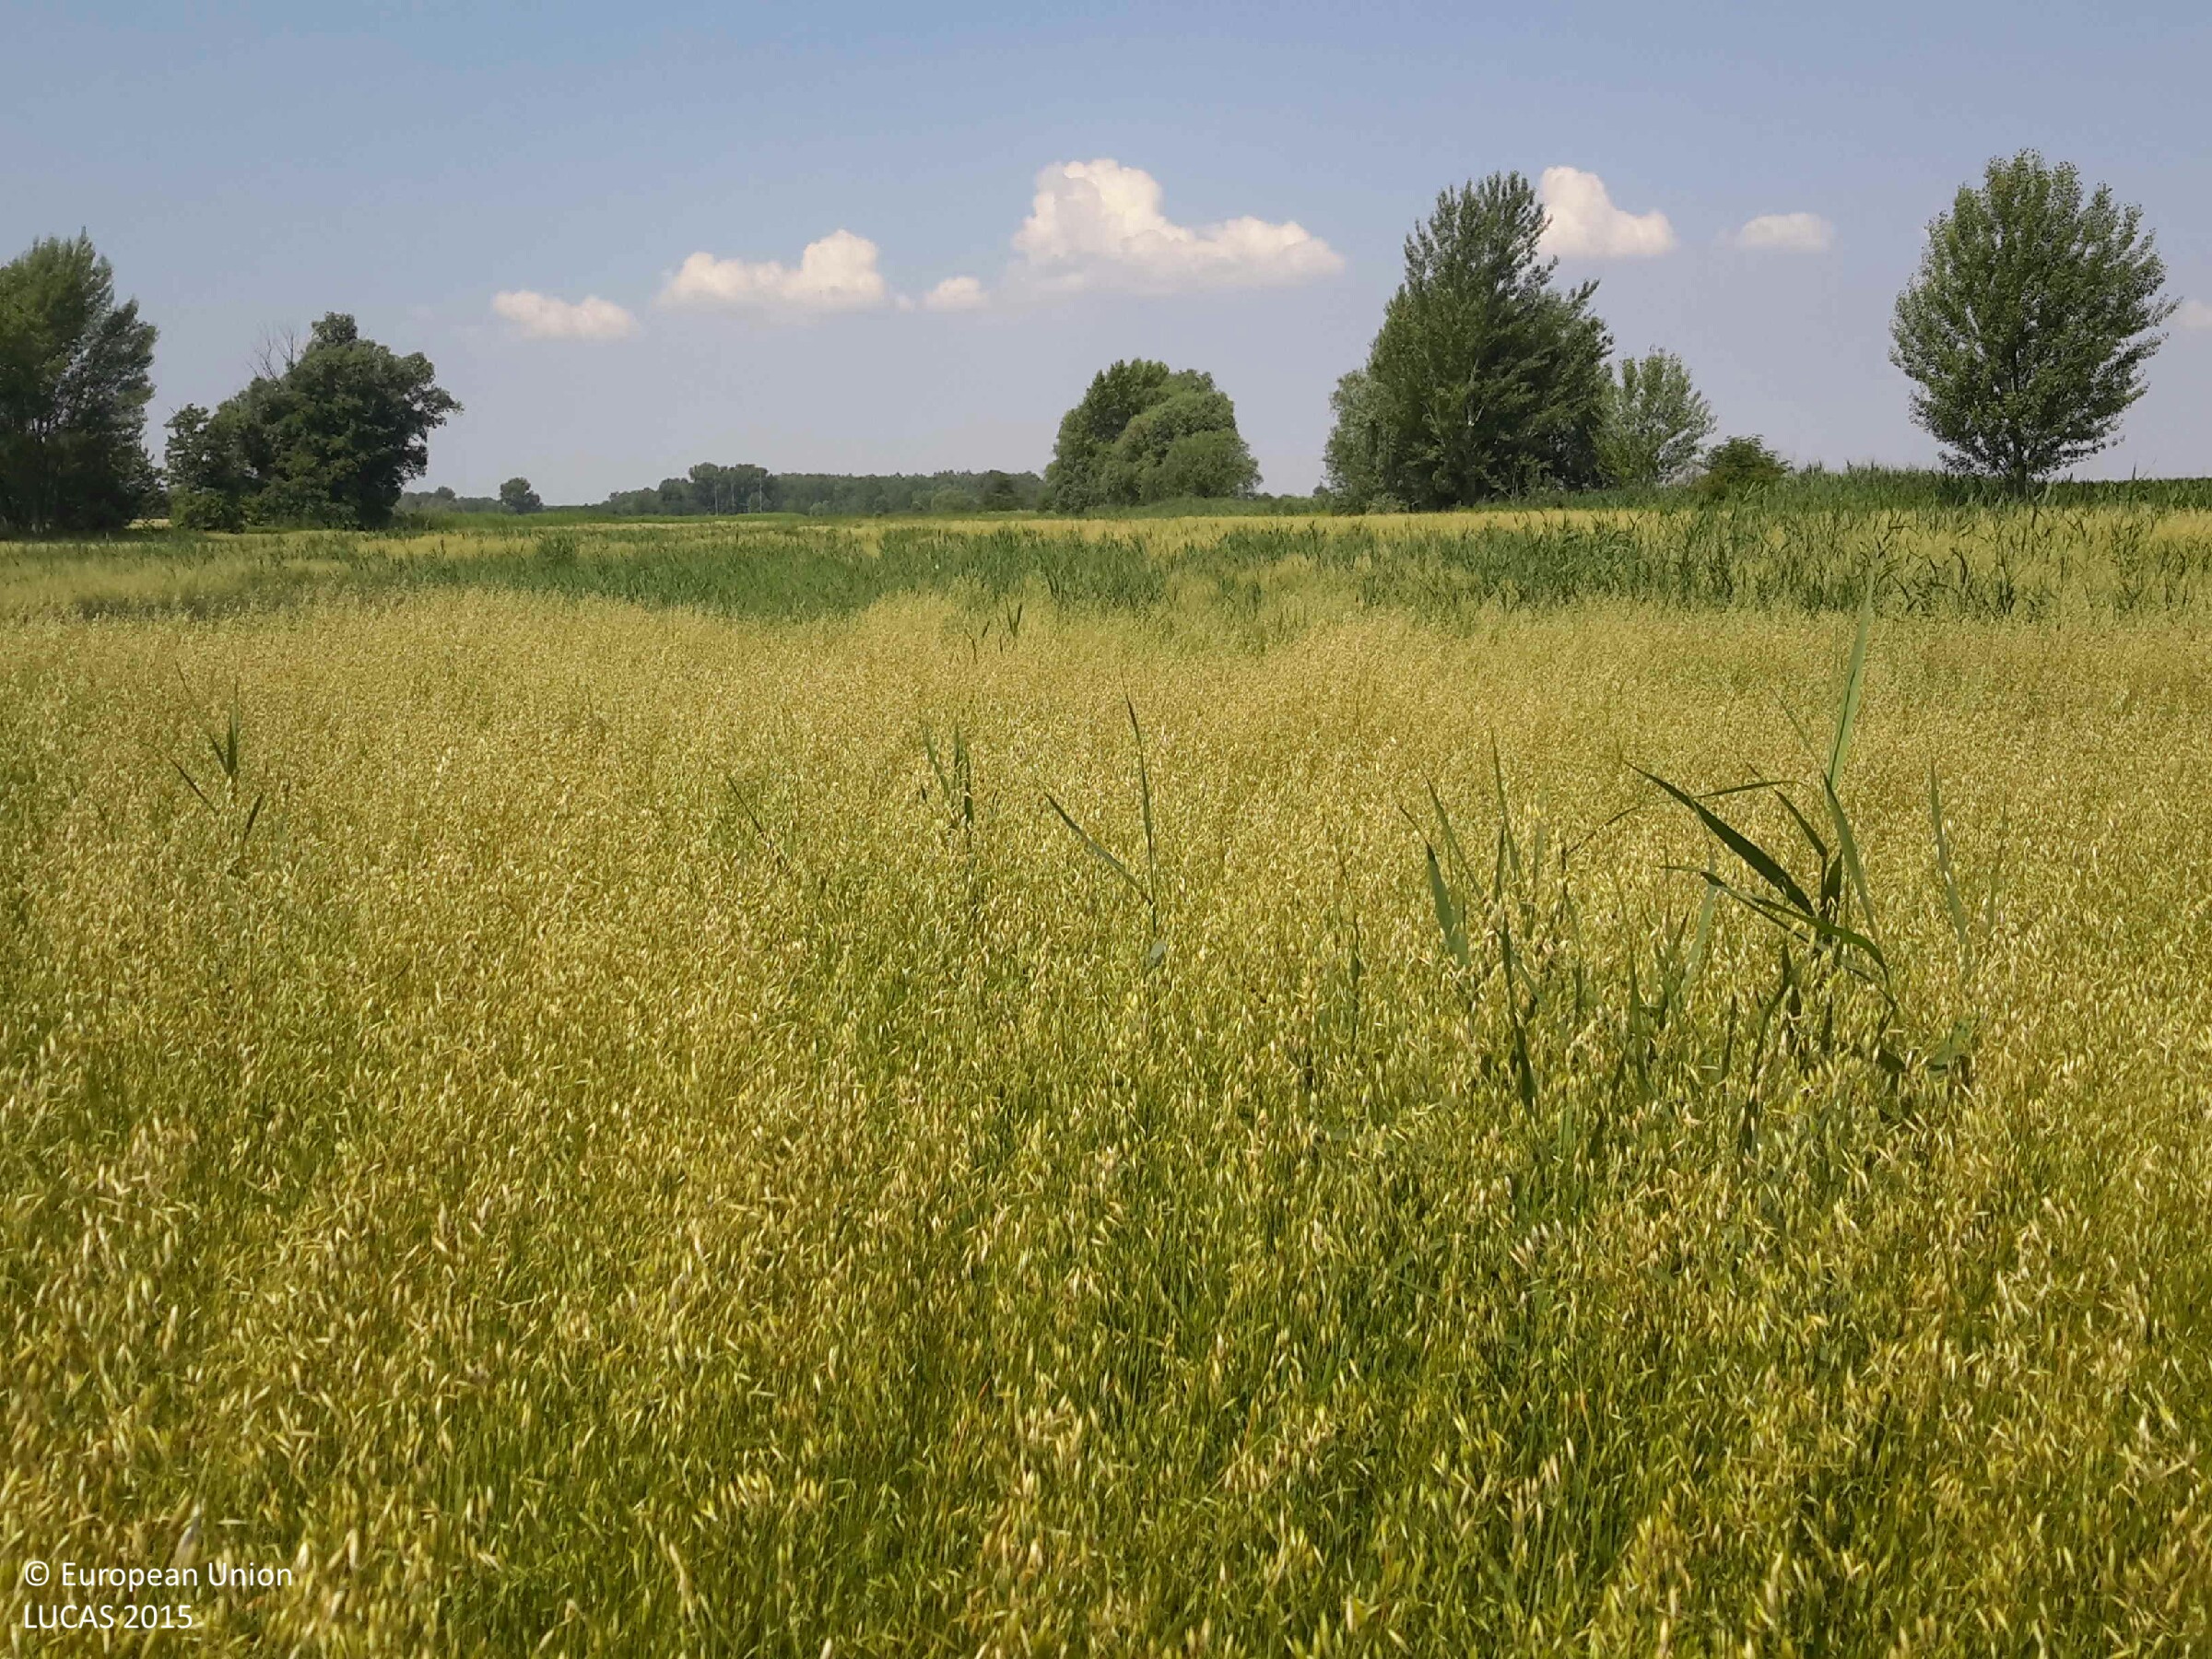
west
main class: Cropland
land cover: Oats
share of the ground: > 75 %
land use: Agriculture (excluding fallow land and kitchen gardens)
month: July
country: HU
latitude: 47.4079
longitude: 17.4952
